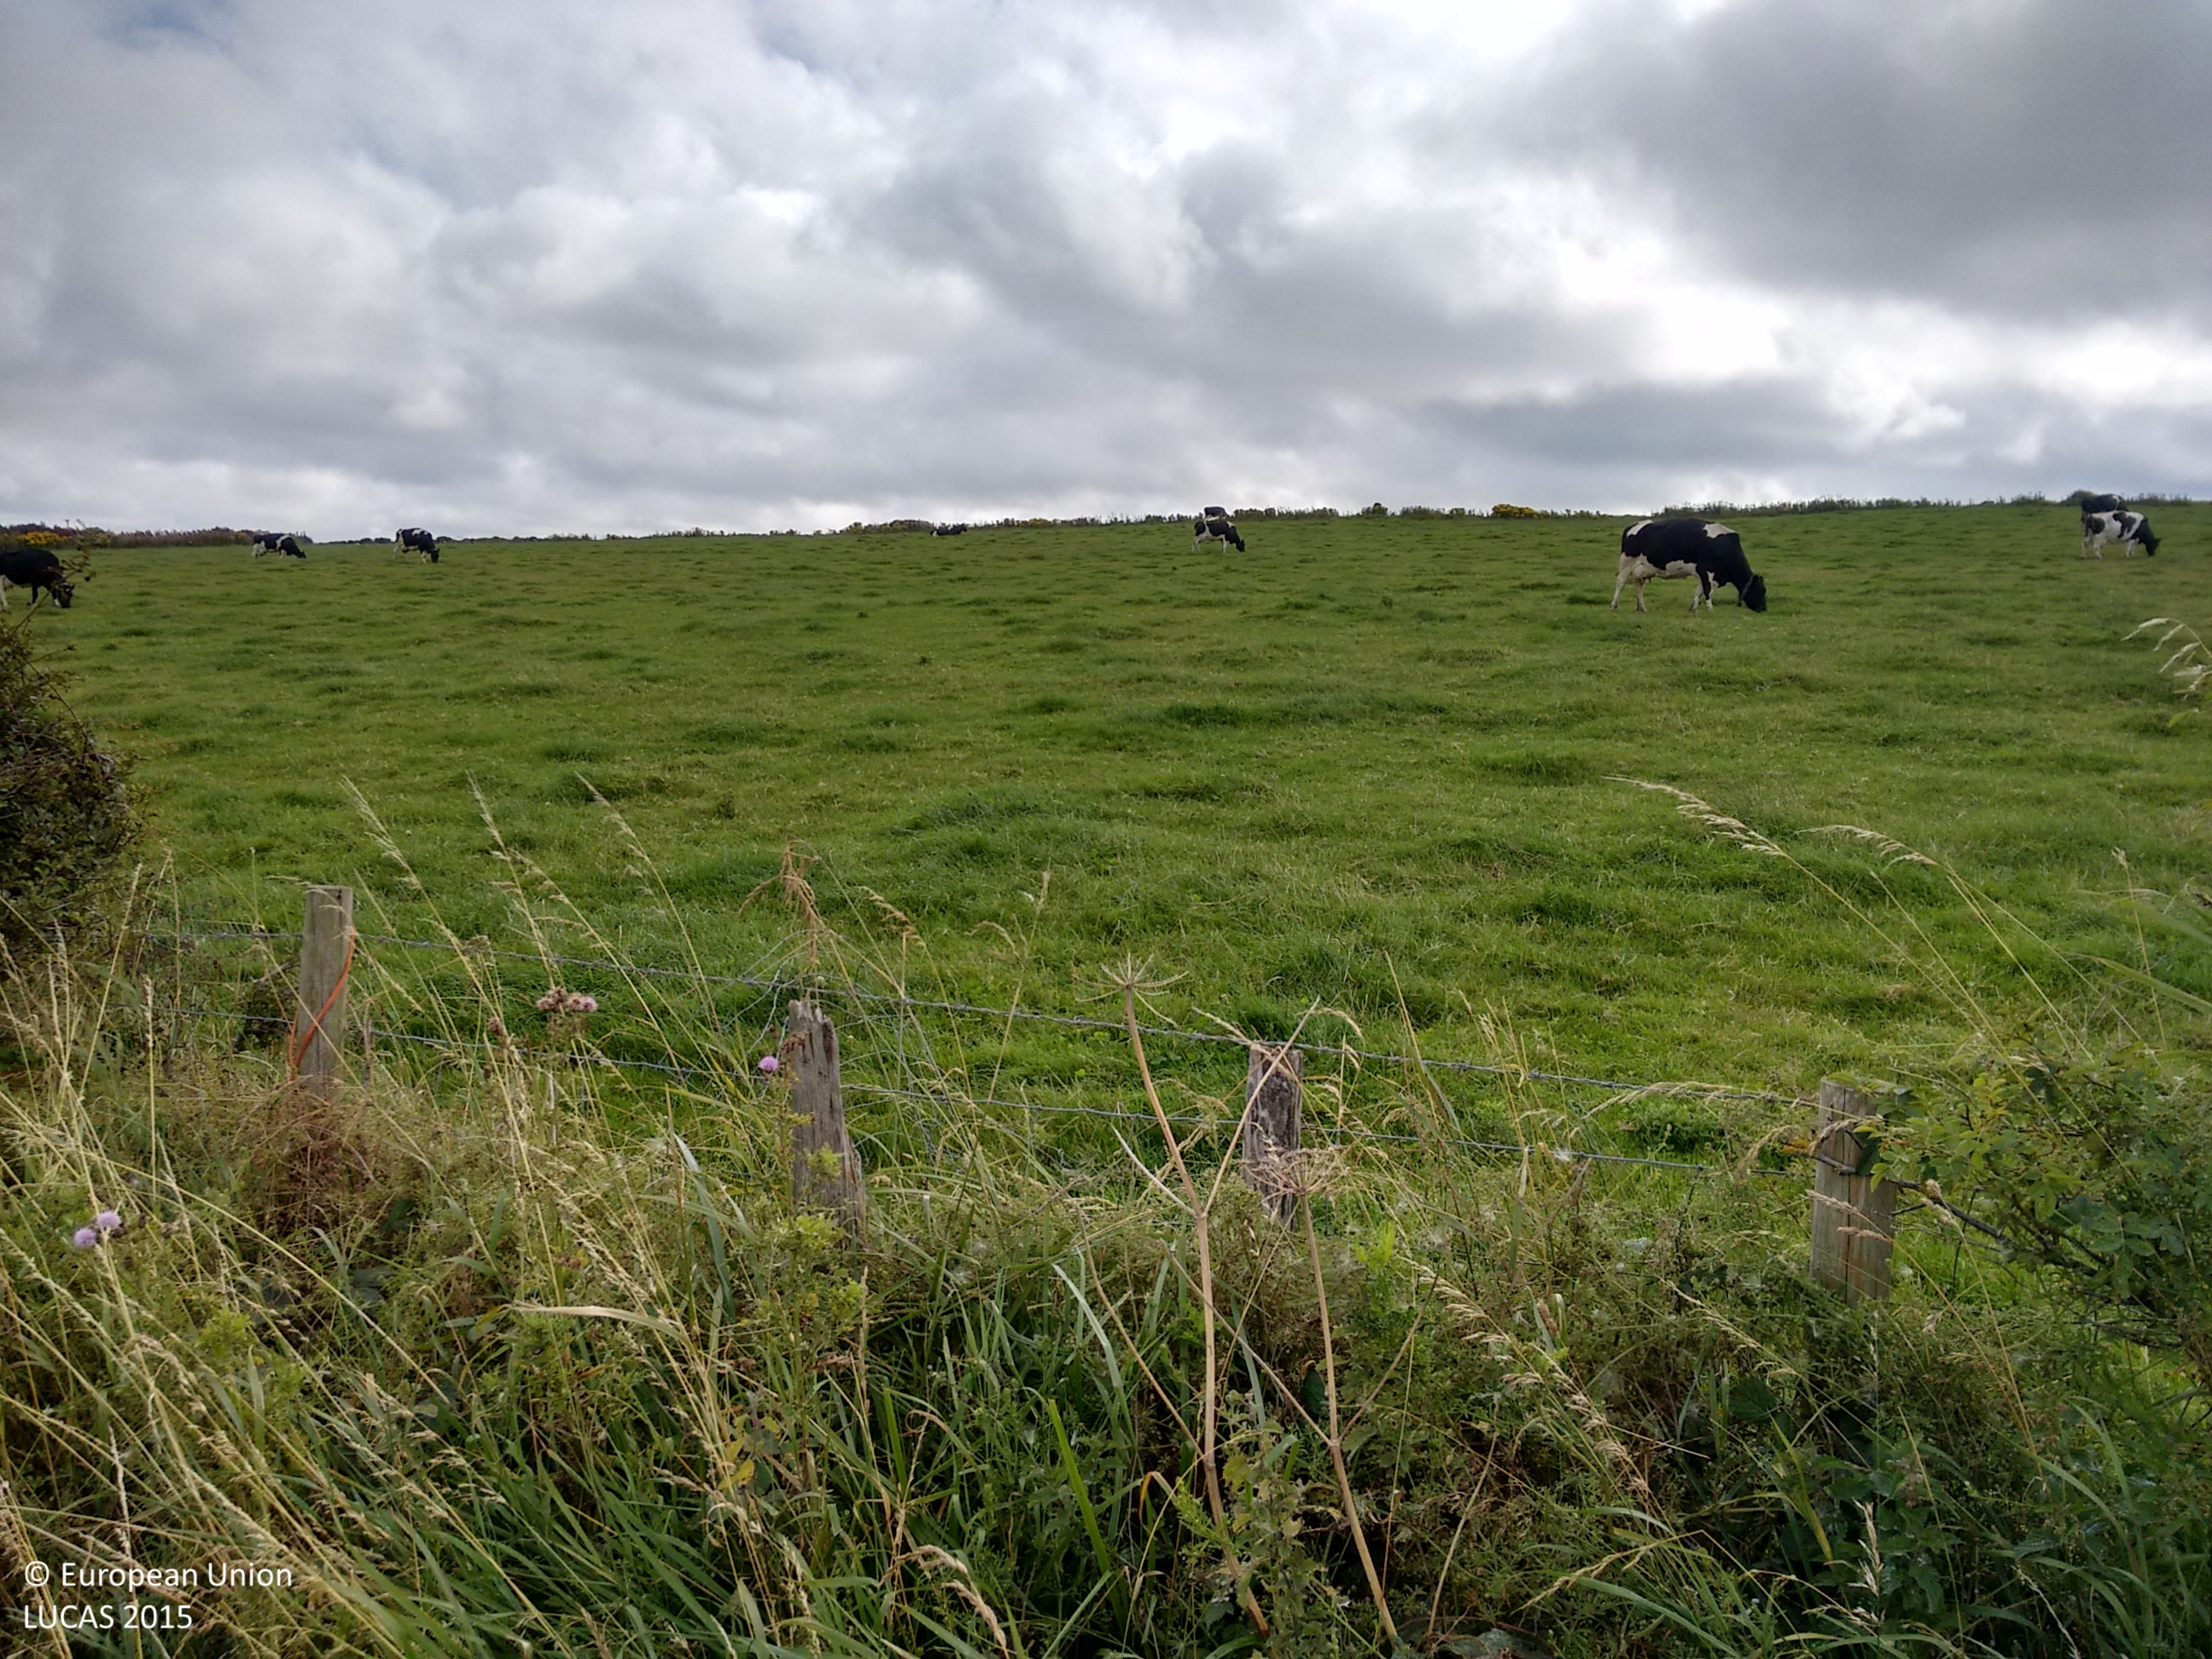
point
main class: Grassland
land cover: Grassland without tree/shrub cover
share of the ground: > 75 %
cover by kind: herbaceous plants 100 %
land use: Agriculture (excluding fallow land and kitchen gardens)
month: August
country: GB
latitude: 54.6046
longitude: -3.5669
